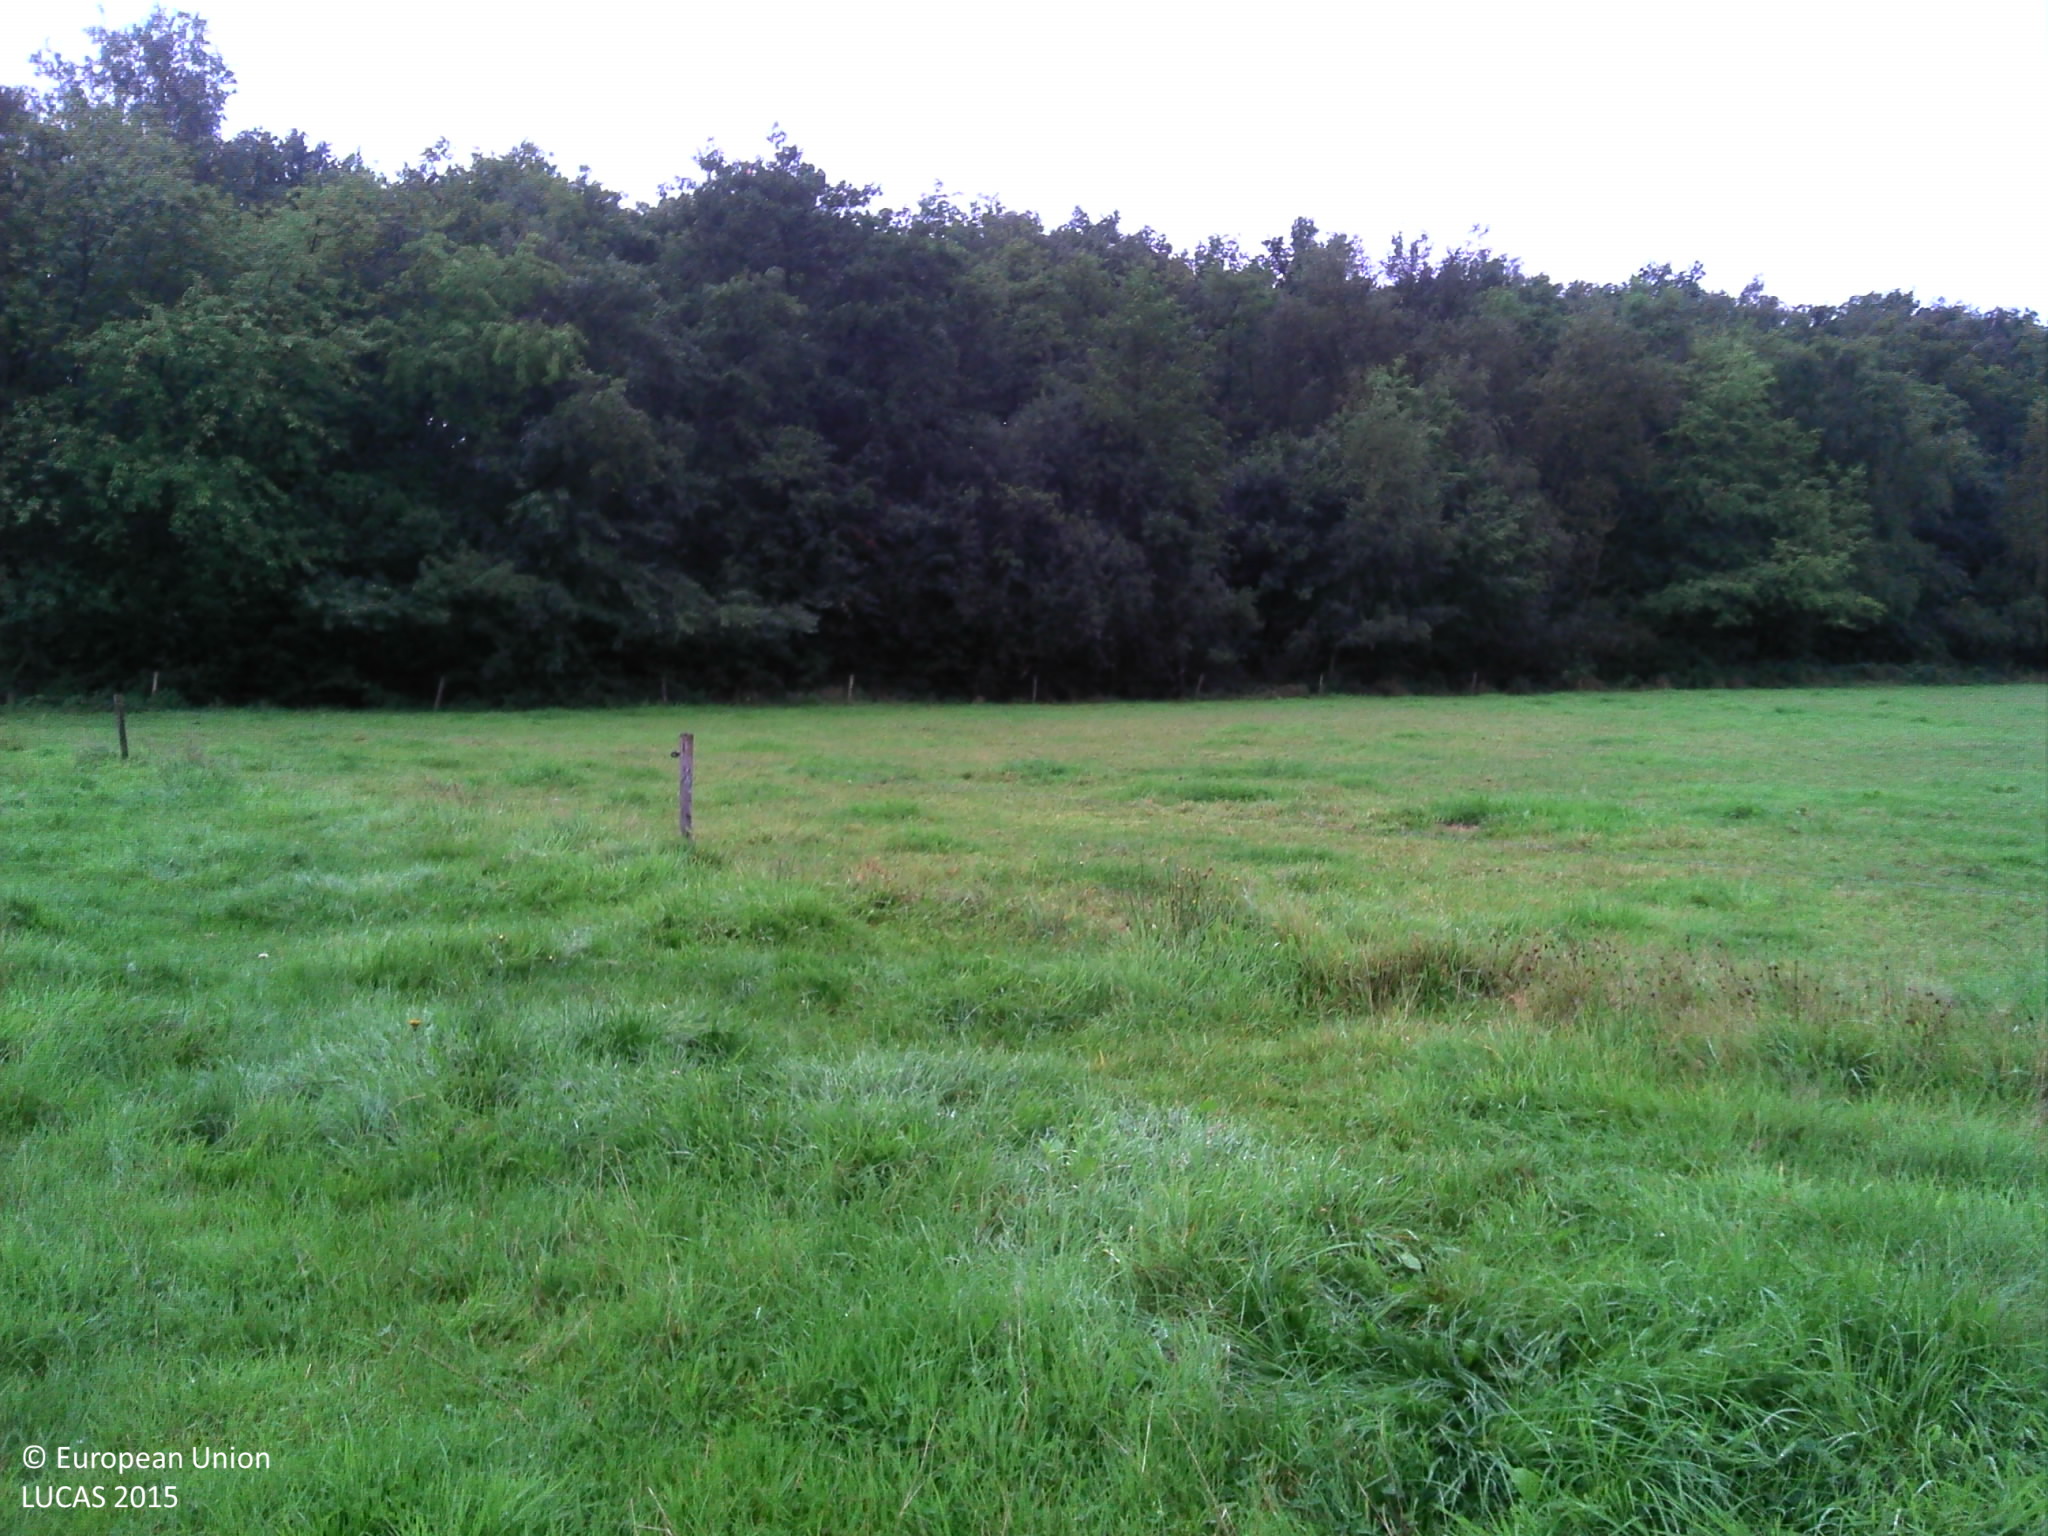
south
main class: Grassland
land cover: Grassland without tree/shrub cover
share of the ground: > 75 %
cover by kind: herbaceous plants 100 %
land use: Agriculture (excluding fallow land and kitchen gardens)
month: September
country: BE
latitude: 51.4312
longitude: 4.7175
